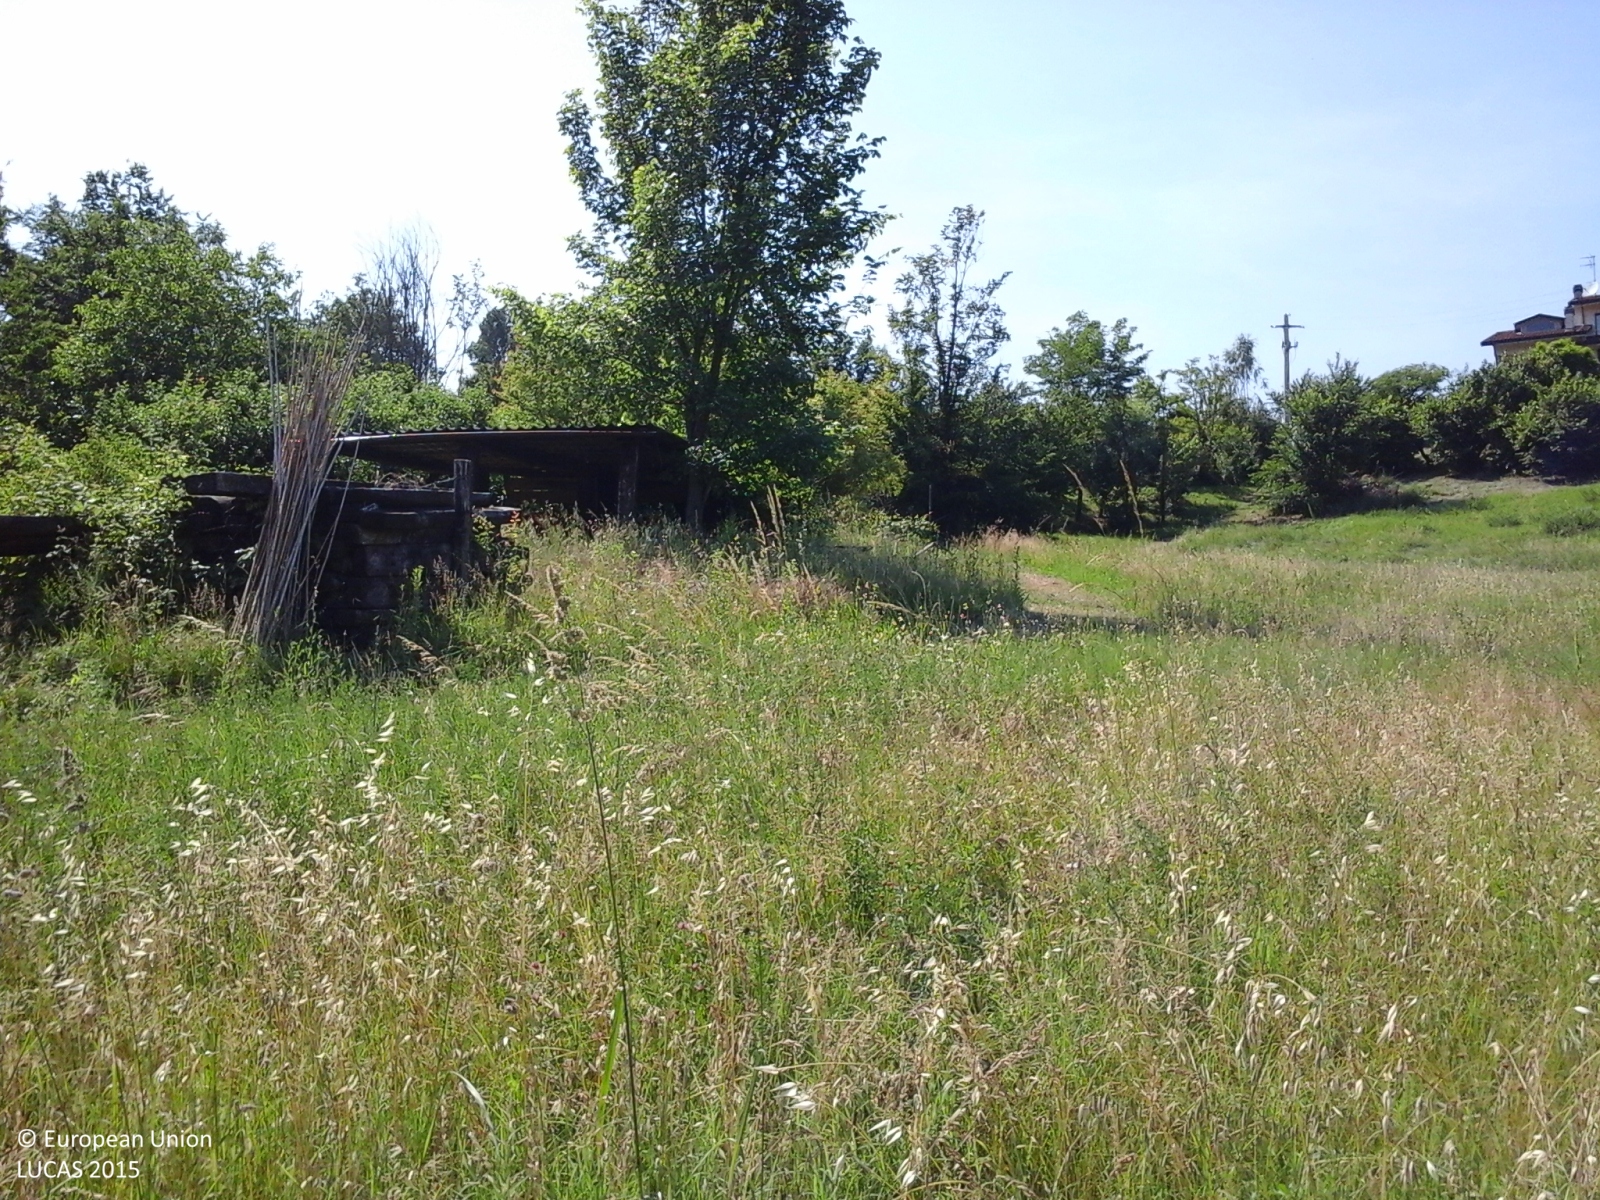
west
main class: Grassland
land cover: Grassland without tree/shrub cover
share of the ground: > 75 %
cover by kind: herbaceous plants 100 %
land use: Agriculture (excluding fallow land and kitchen gardens)
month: May
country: IT
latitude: 44.8194
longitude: 10.0126
